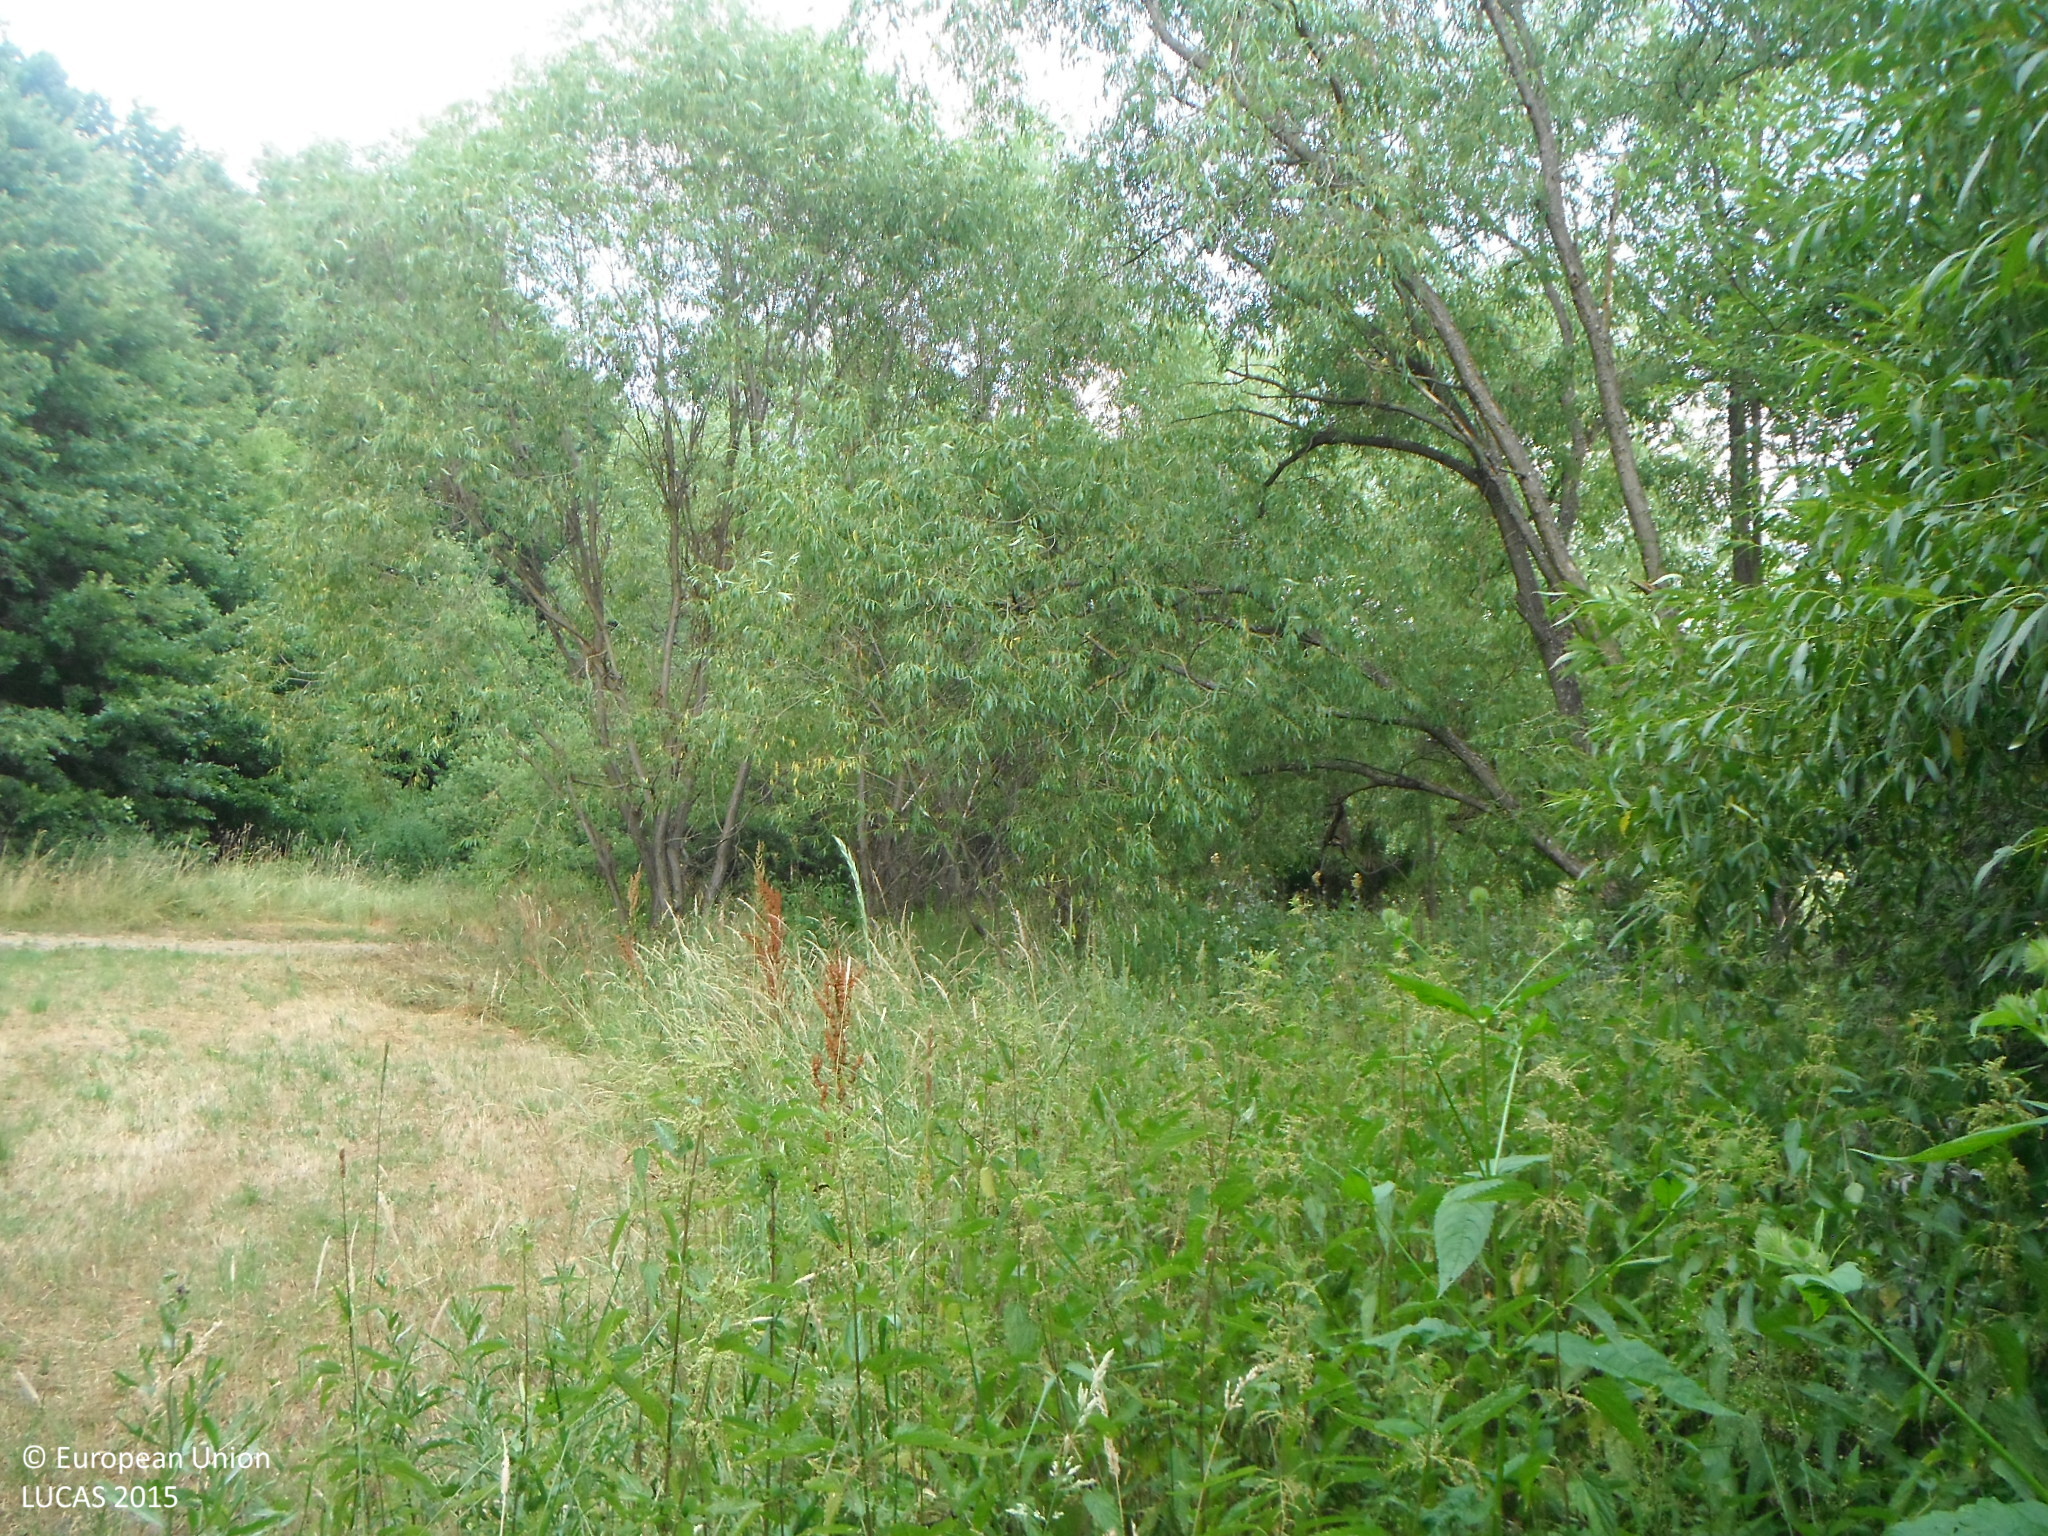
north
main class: Woodland
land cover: Broadleaved woodland
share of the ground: > 75 %
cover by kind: broadleaved forest trees 90 %, herbaceous plants 10 %
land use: Semi-natural and natural areas not in use
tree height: > 5 m
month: July
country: SK
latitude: 48.3666
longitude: 19.1599
